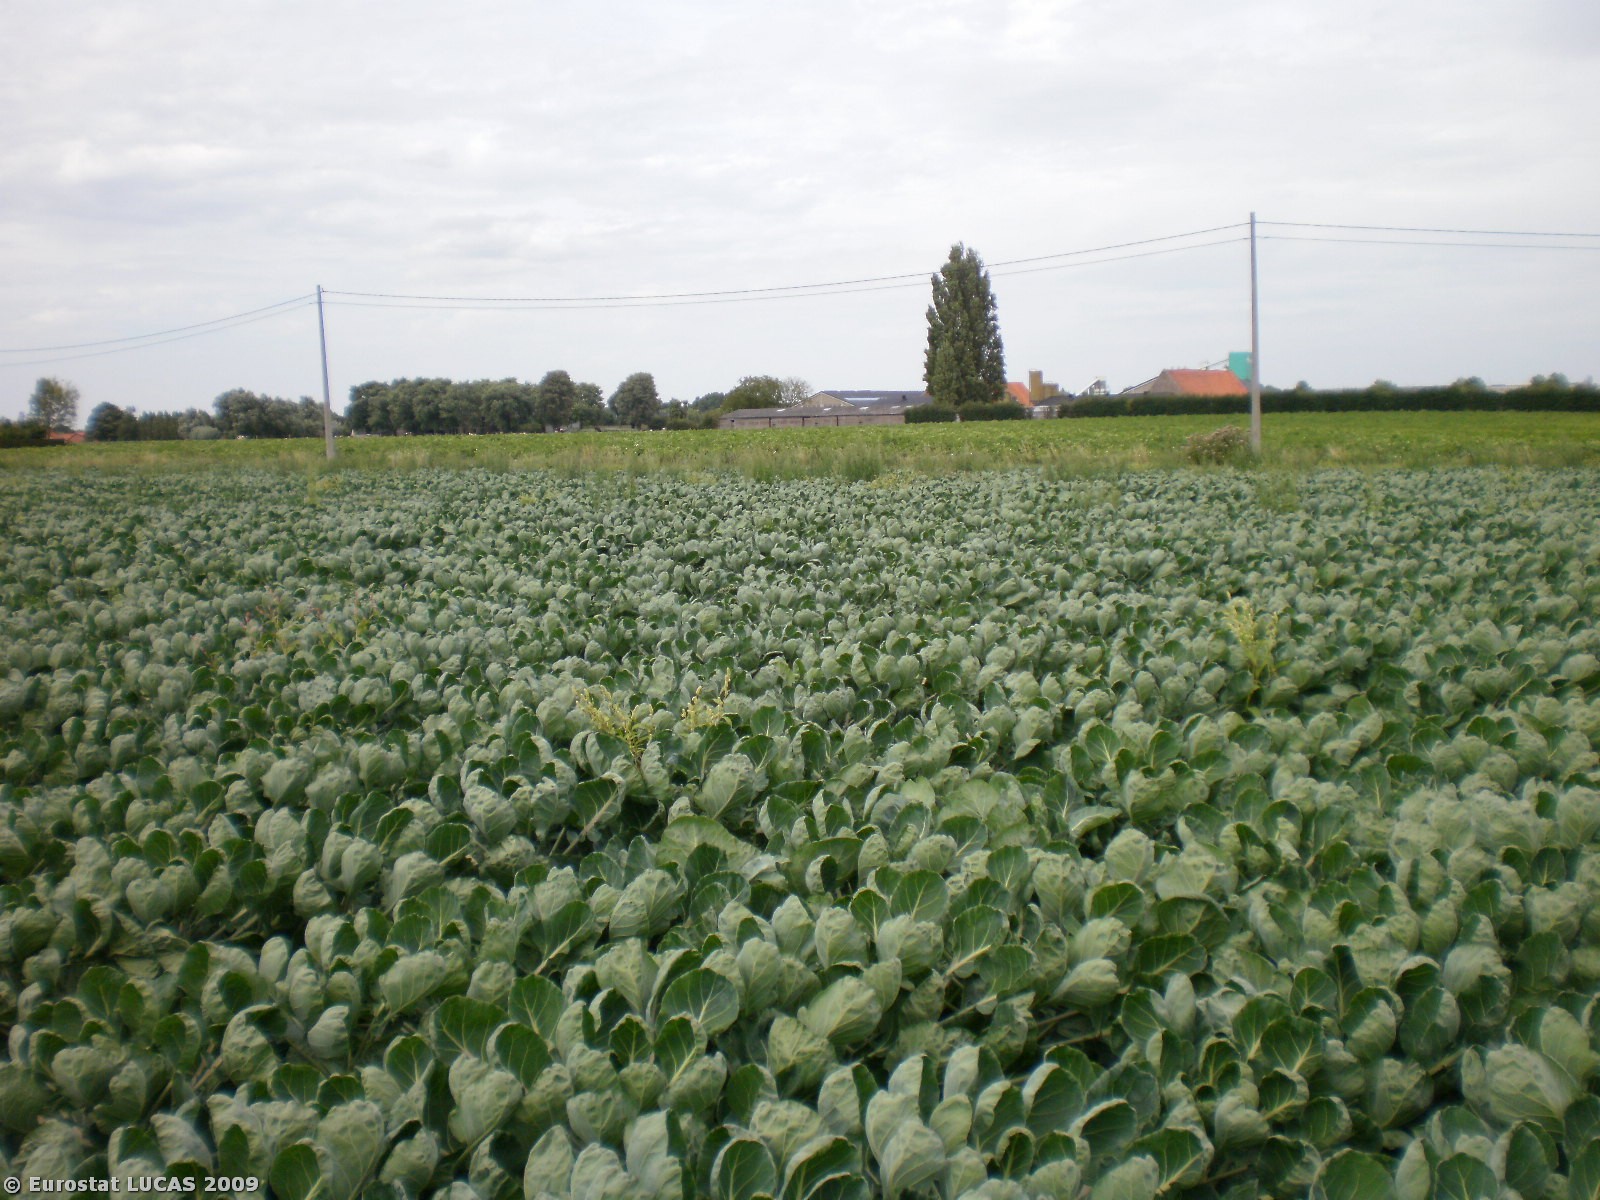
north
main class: Cropland
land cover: Other fresh vegetables
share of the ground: > 75 %
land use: Agriculture (excluding fallow land and kitchen gardens)
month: July
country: BE
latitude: 50.8422
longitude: 2.8172
